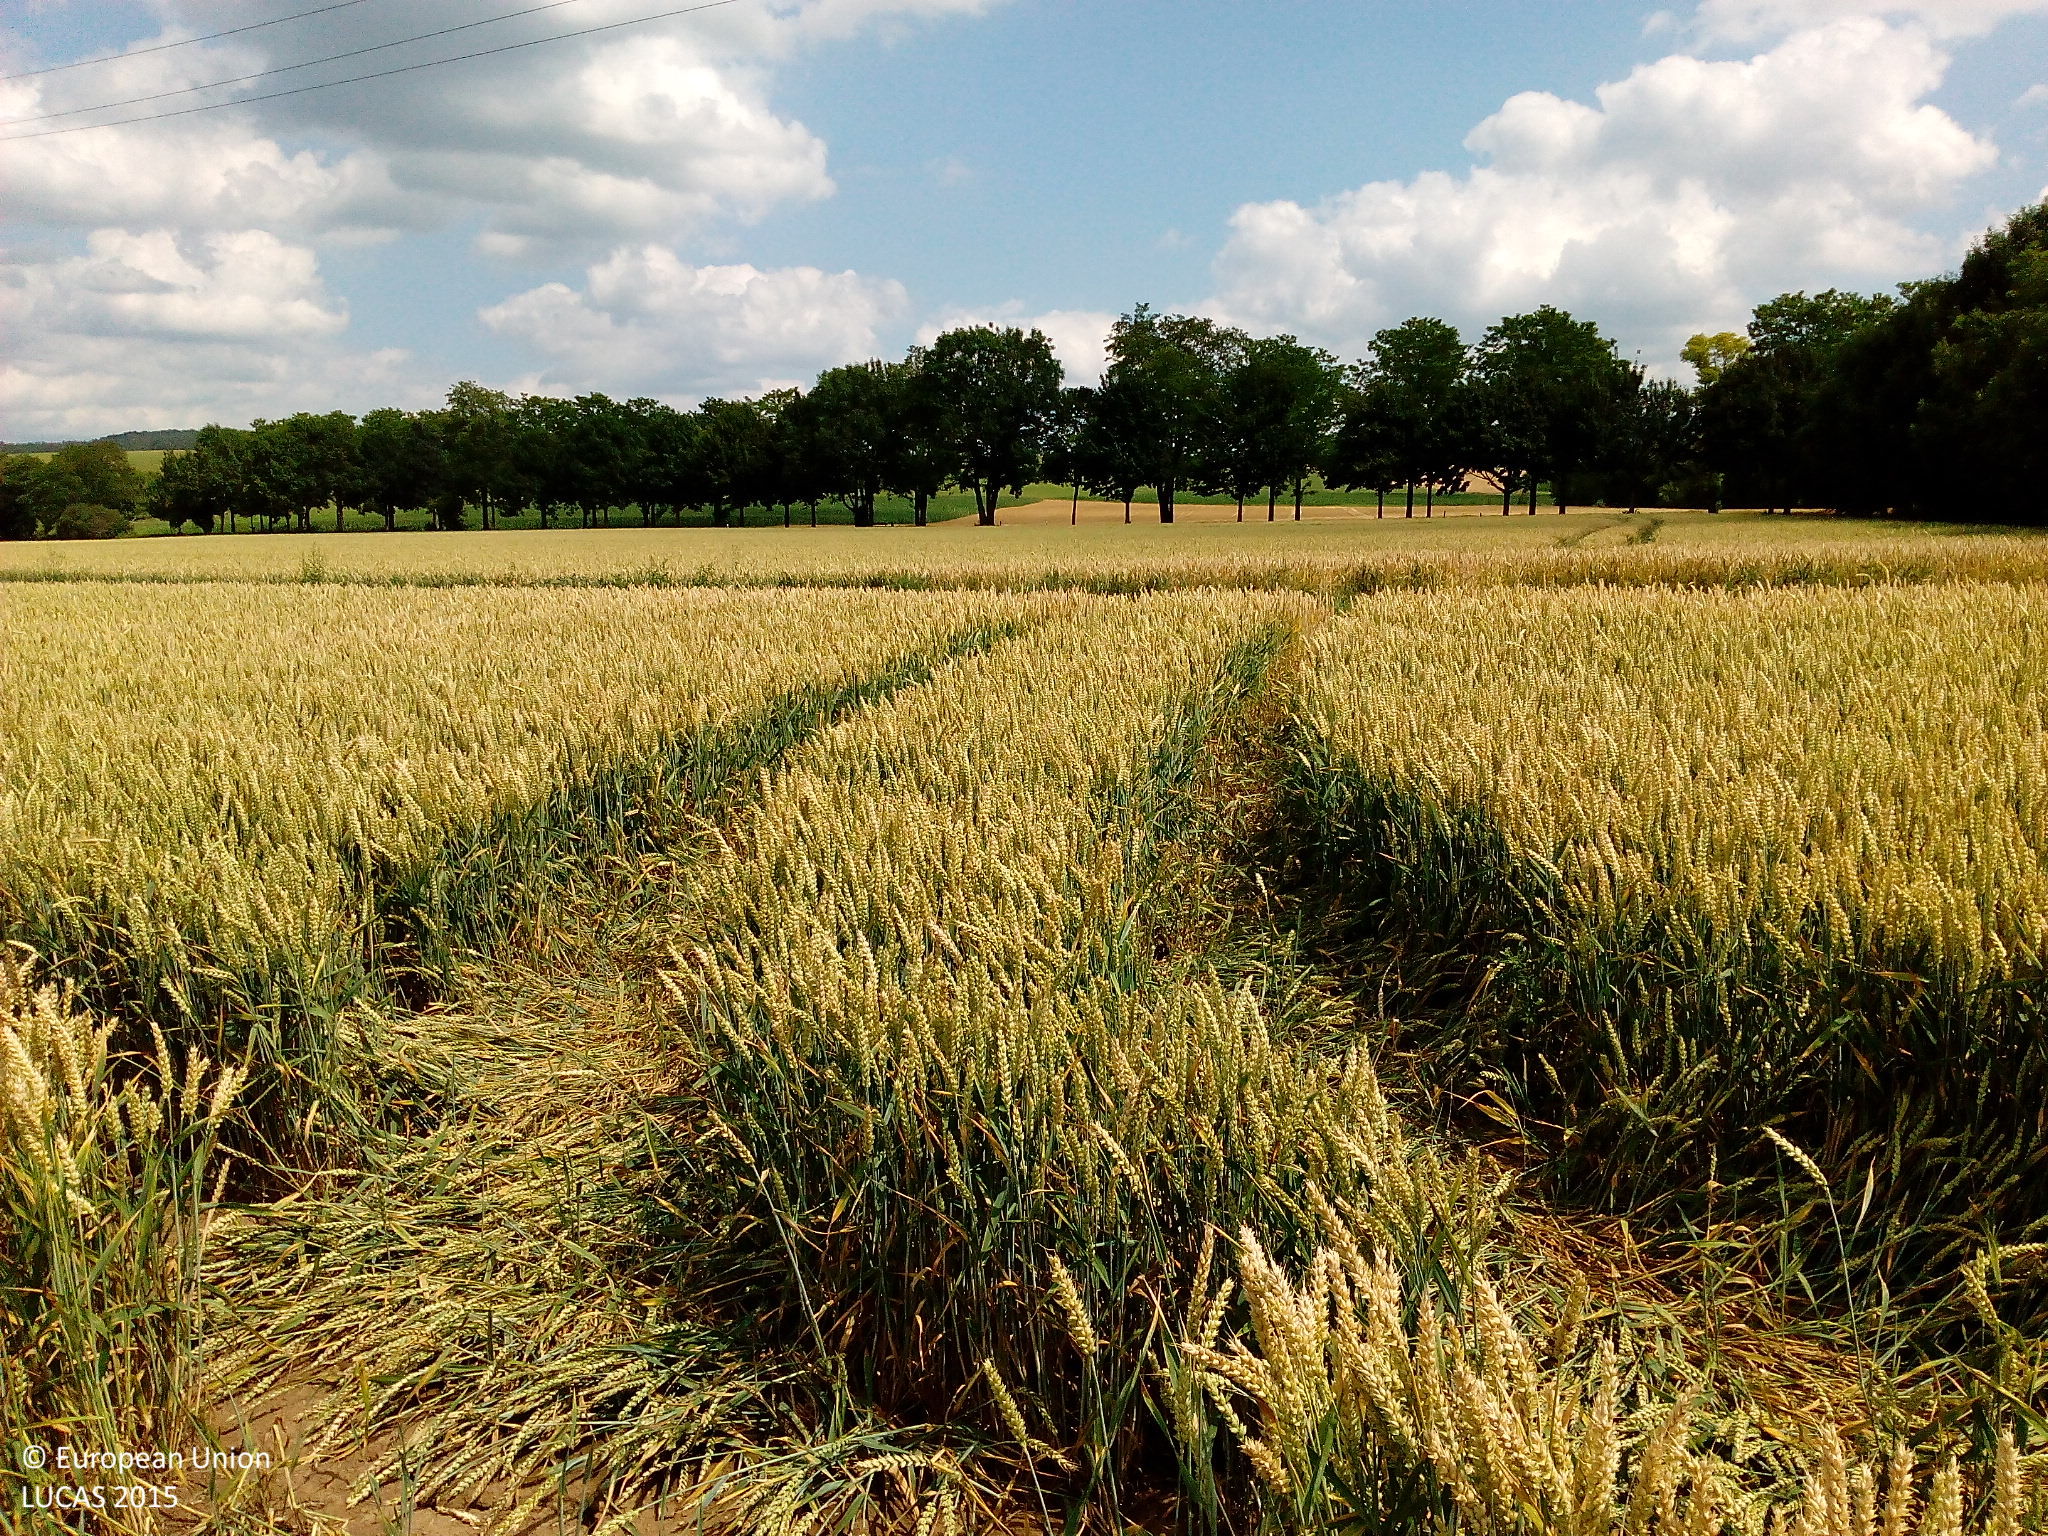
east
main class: Cropland
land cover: Common wheat
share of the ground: > 75 %
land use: Agriculture (excluding fallow land and kitchen gardens)
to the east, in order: Common wheat; Grass margins; Tracks; Electric lines; Grass margins; Common wheat; Lines of trees; Paved roads, cycling and walking lanes; Lines of trees; Ditches and canals; Grass margins; Paved roads, cycling and walking lanes; Lines of trees; Grass margins; Barley
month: July
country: DE
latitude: 50.7236
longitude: 9.9575
